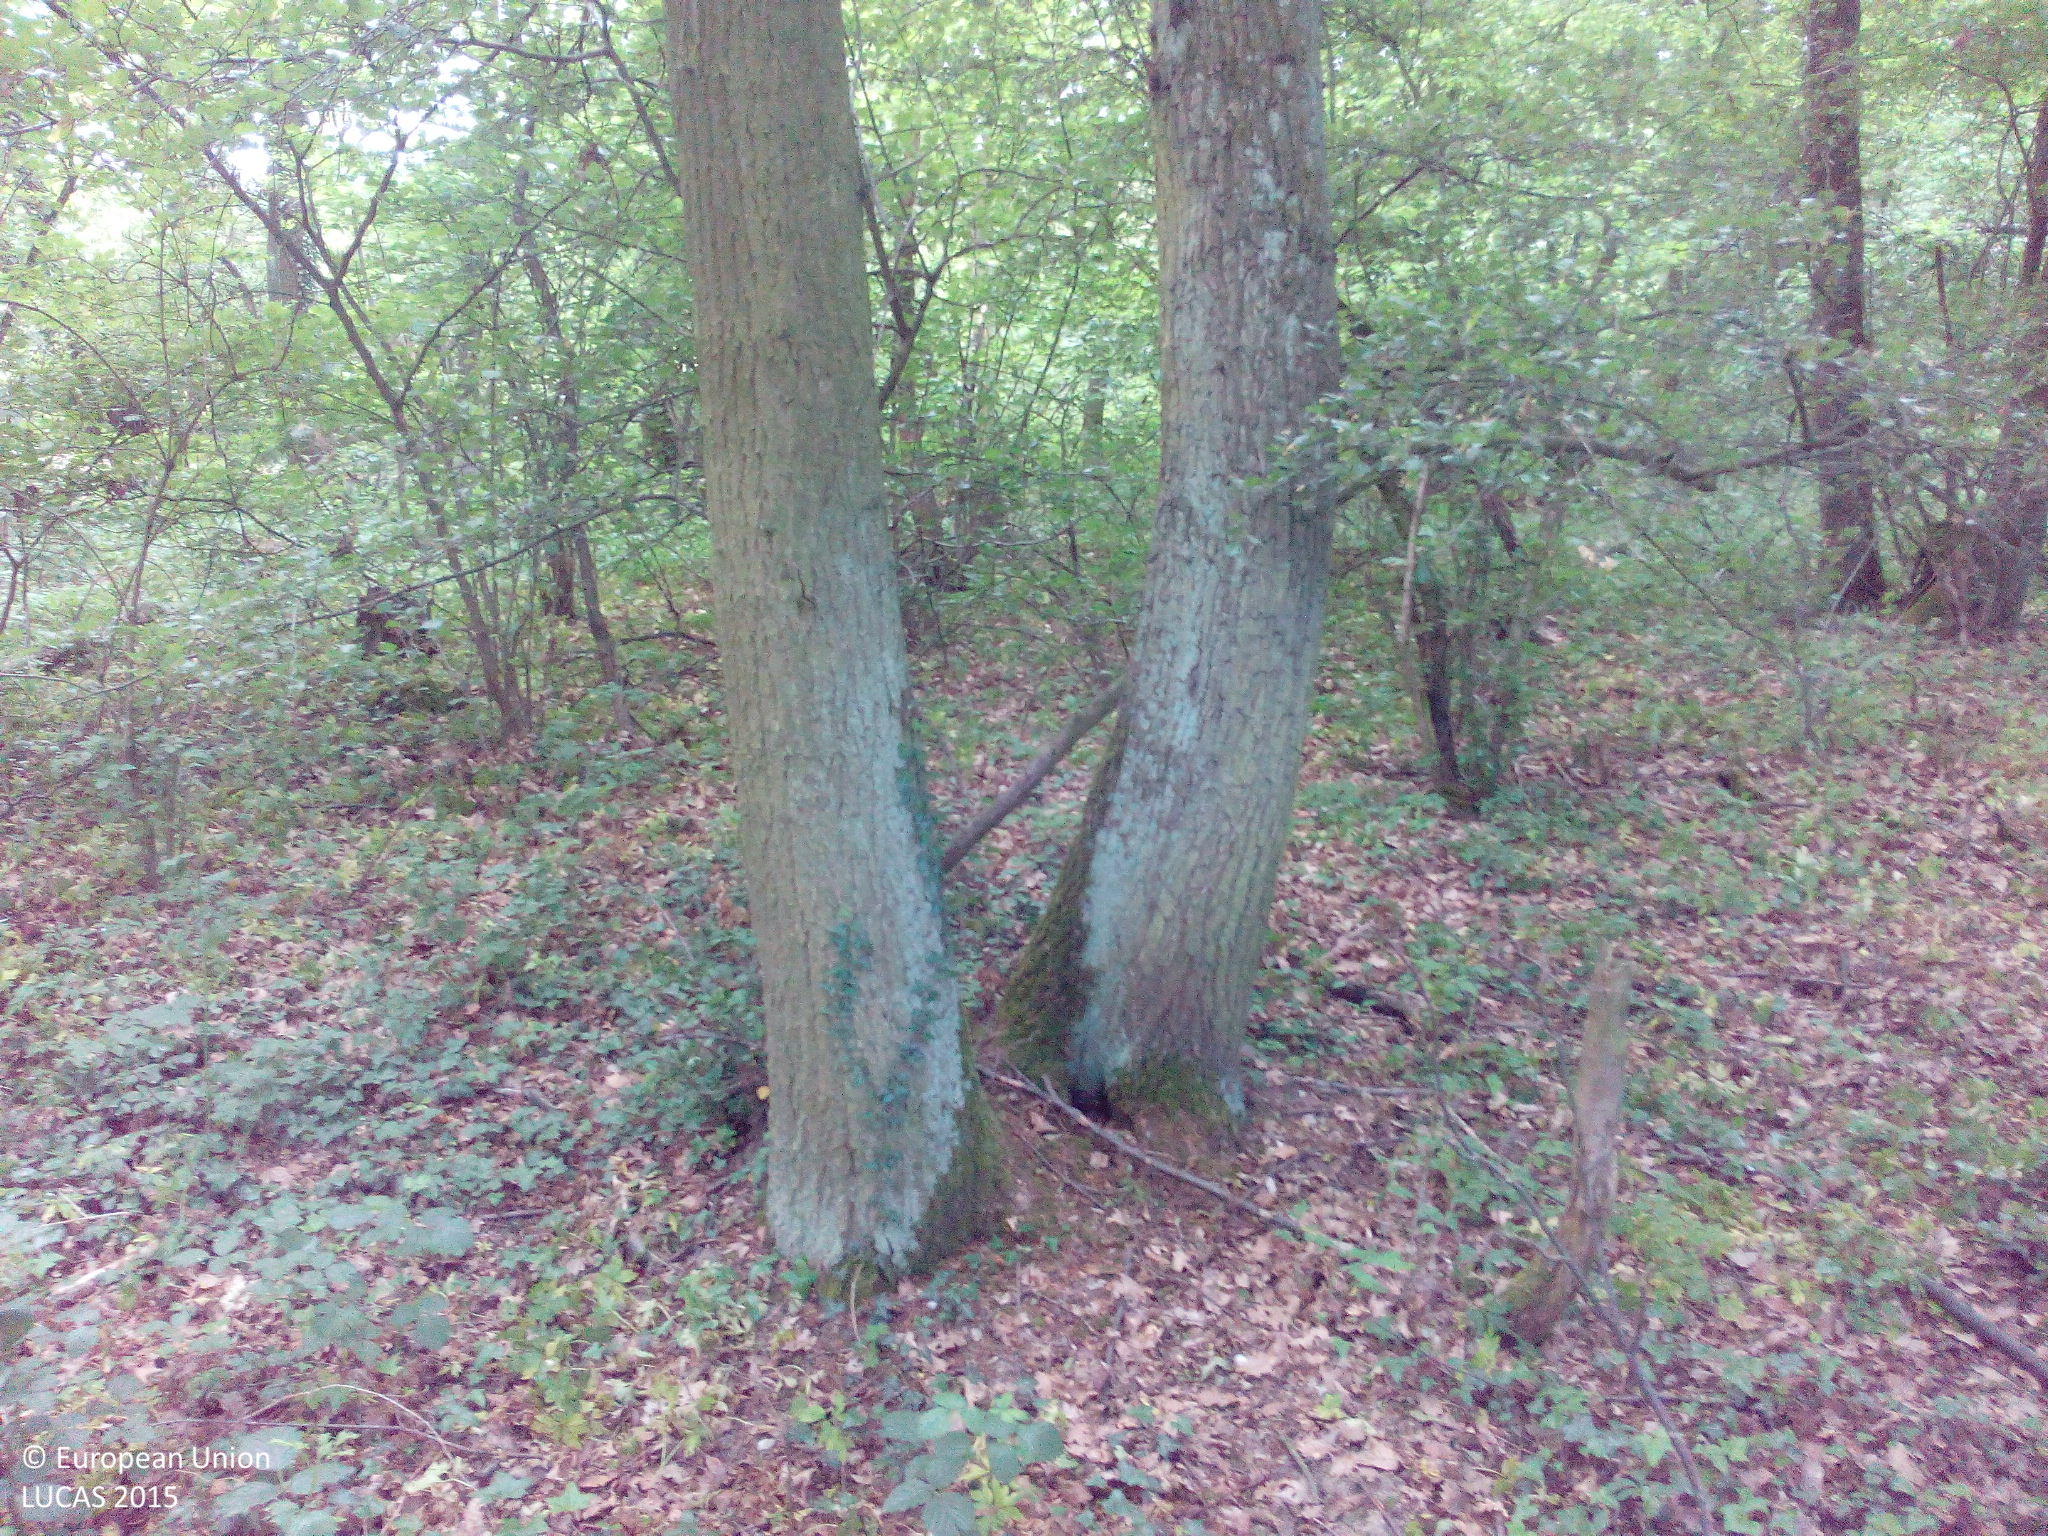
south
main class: Woodland
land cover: Broadleaved woodland
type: mesophytic deciduous forest
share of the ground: > 75 %
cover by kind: broadleaved forest trees 80 %, herbaceous plants 10 %, shrubs 5 %, unconsolidated bare surface 5 %
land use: Forestry
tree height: > 5 m
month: May
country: DE
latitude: 49.9515
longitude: 8.0353
